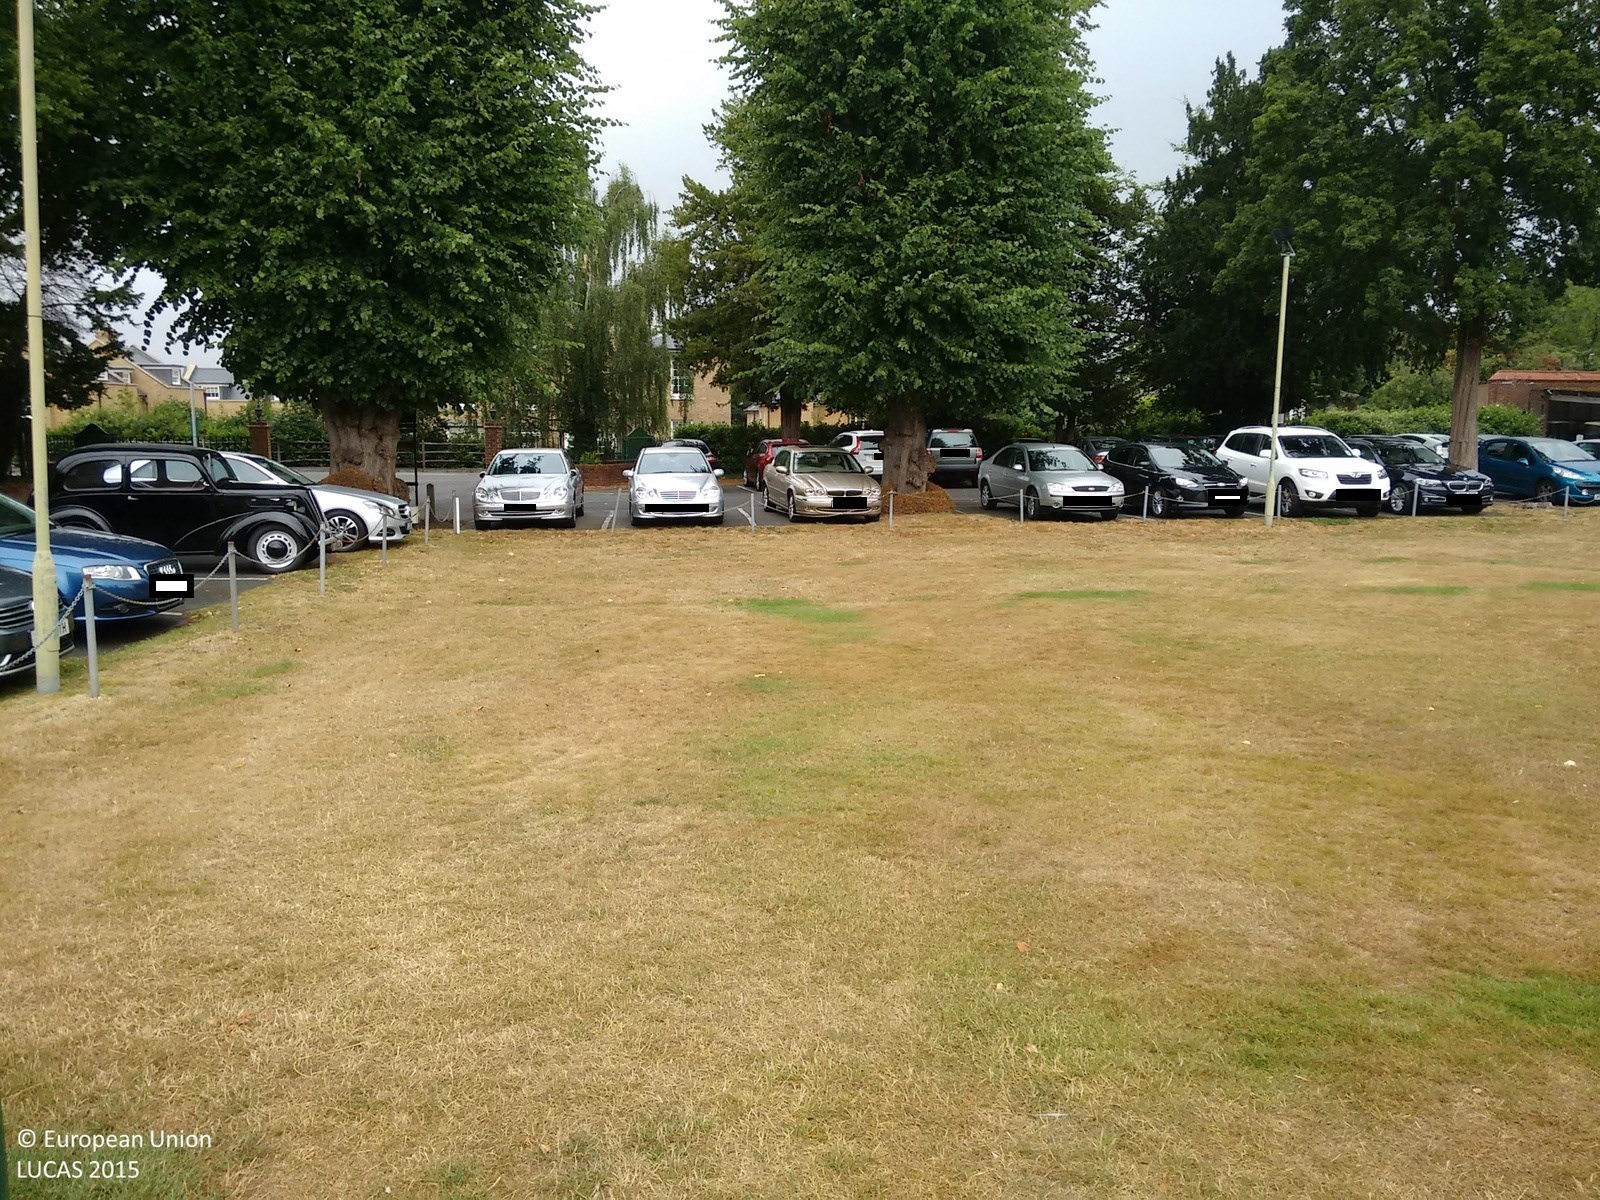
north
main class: Grassland
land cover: Grassland without tree/shrub cover
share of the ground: > 75 %
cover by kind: herbaceous plants 100 %
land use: Sport
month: July
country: GB
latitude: 51.2667
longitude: -0.3994
